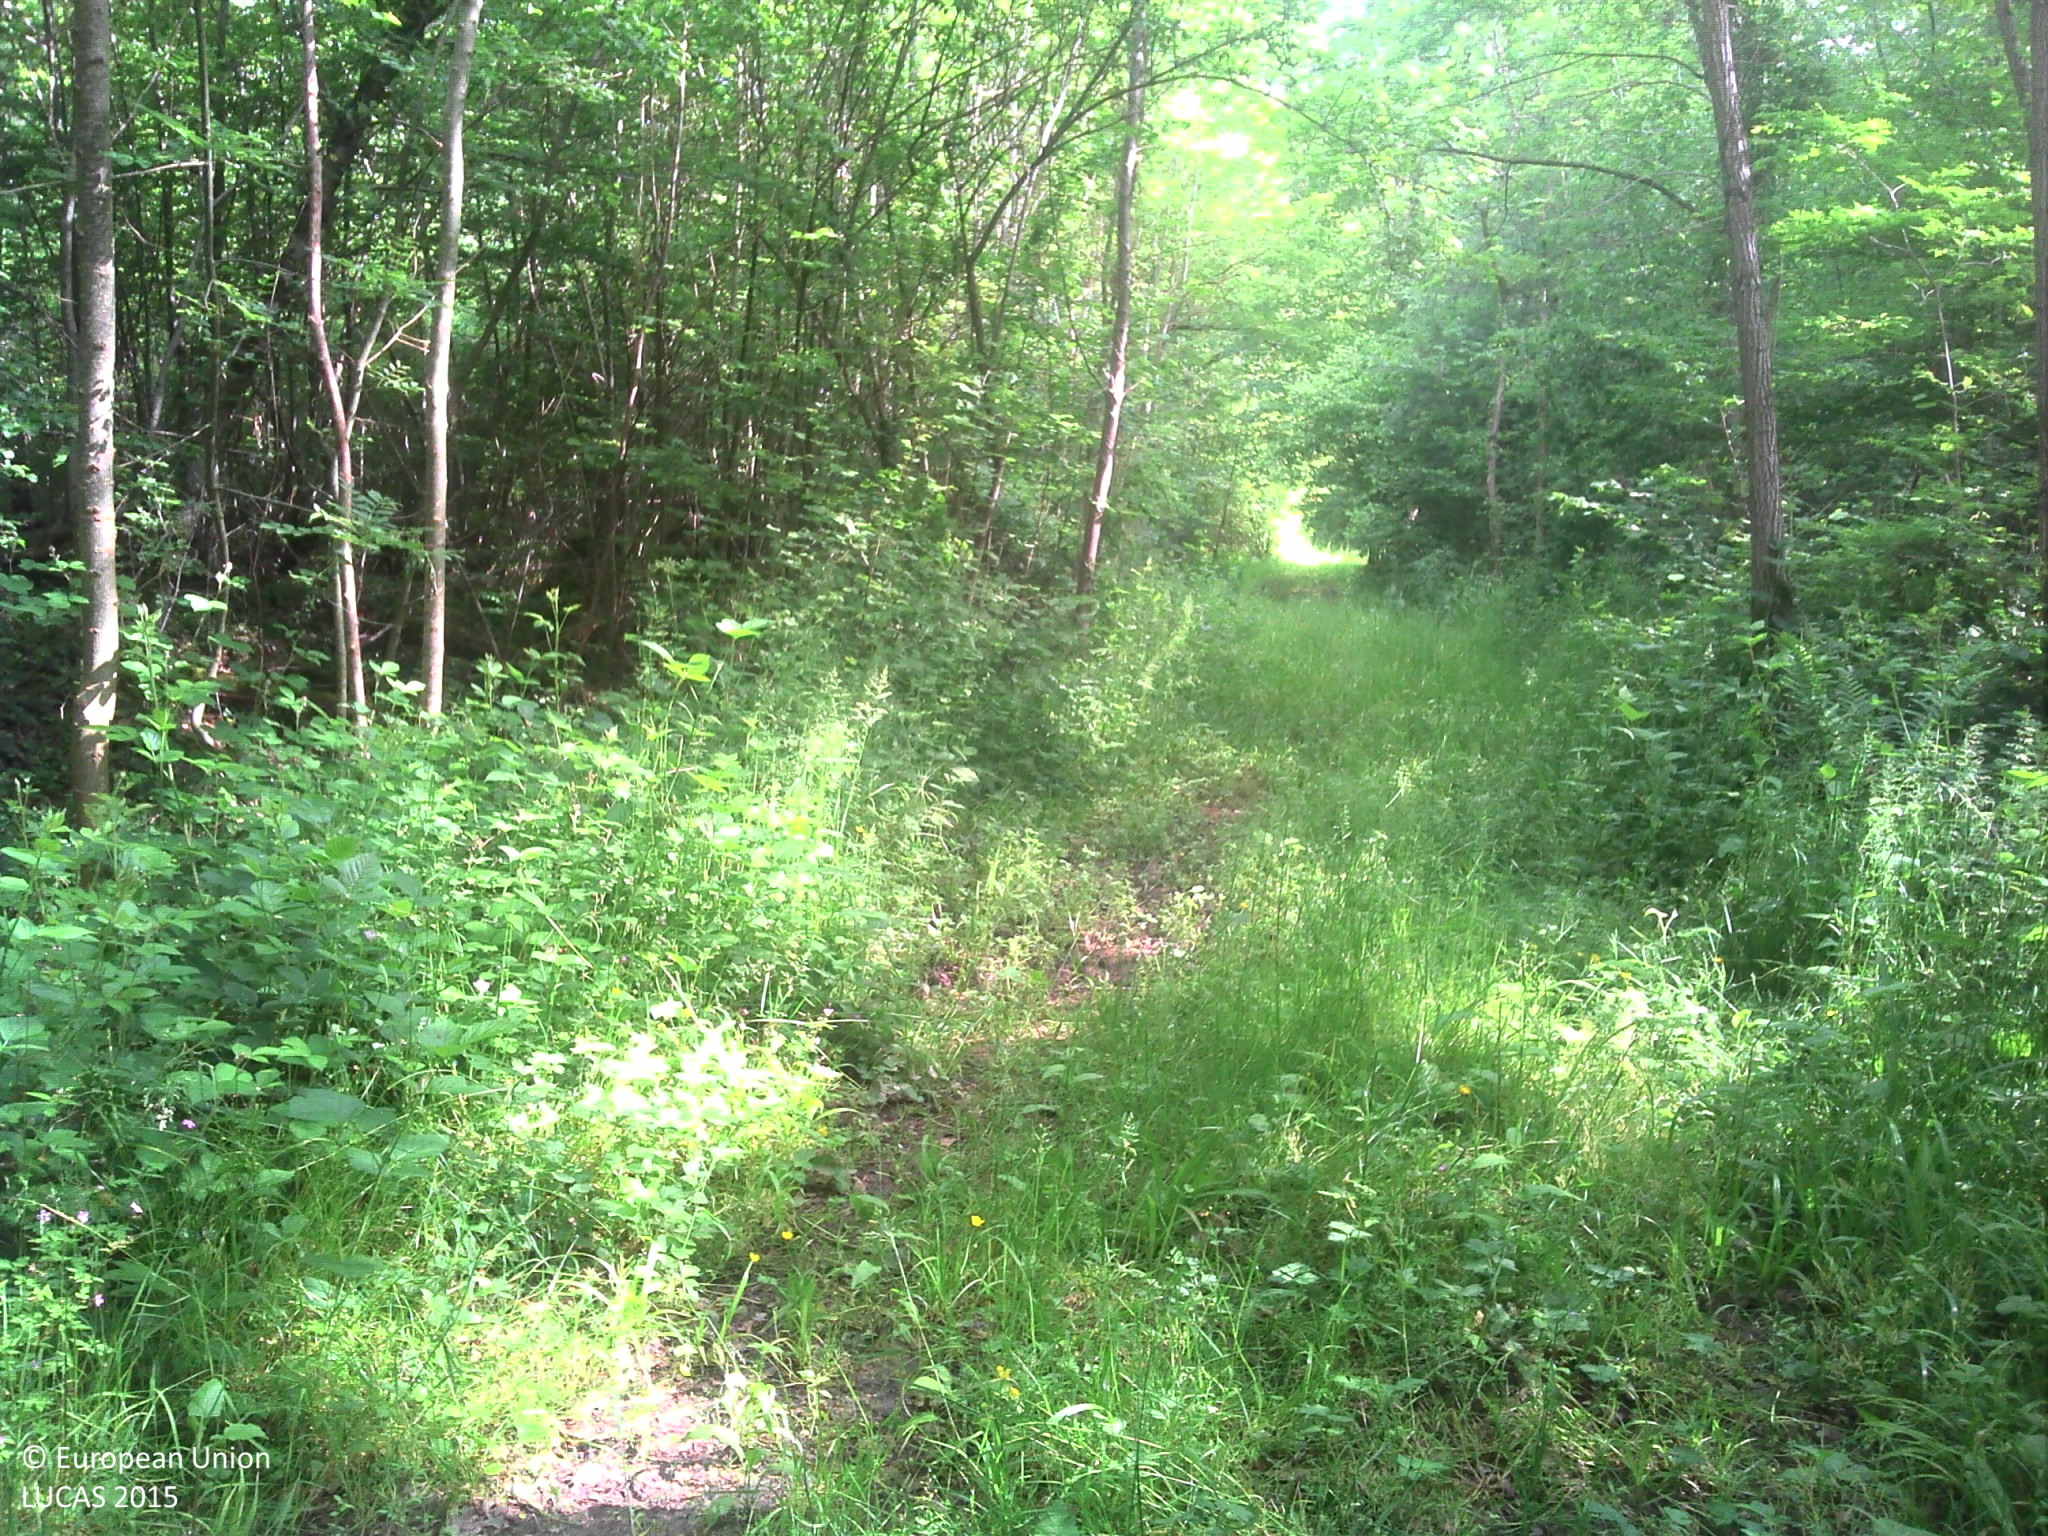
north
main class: Woodland
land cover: Broadleaved woodland
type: mesophytic deciduous forest
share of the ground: > 75 %
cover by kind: broadleaved forest trees 90 %, herbaceous plants 10 %
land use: Forestry
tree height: > 5 m
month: May
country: FR
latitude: 48.6827
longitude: 4.9045
